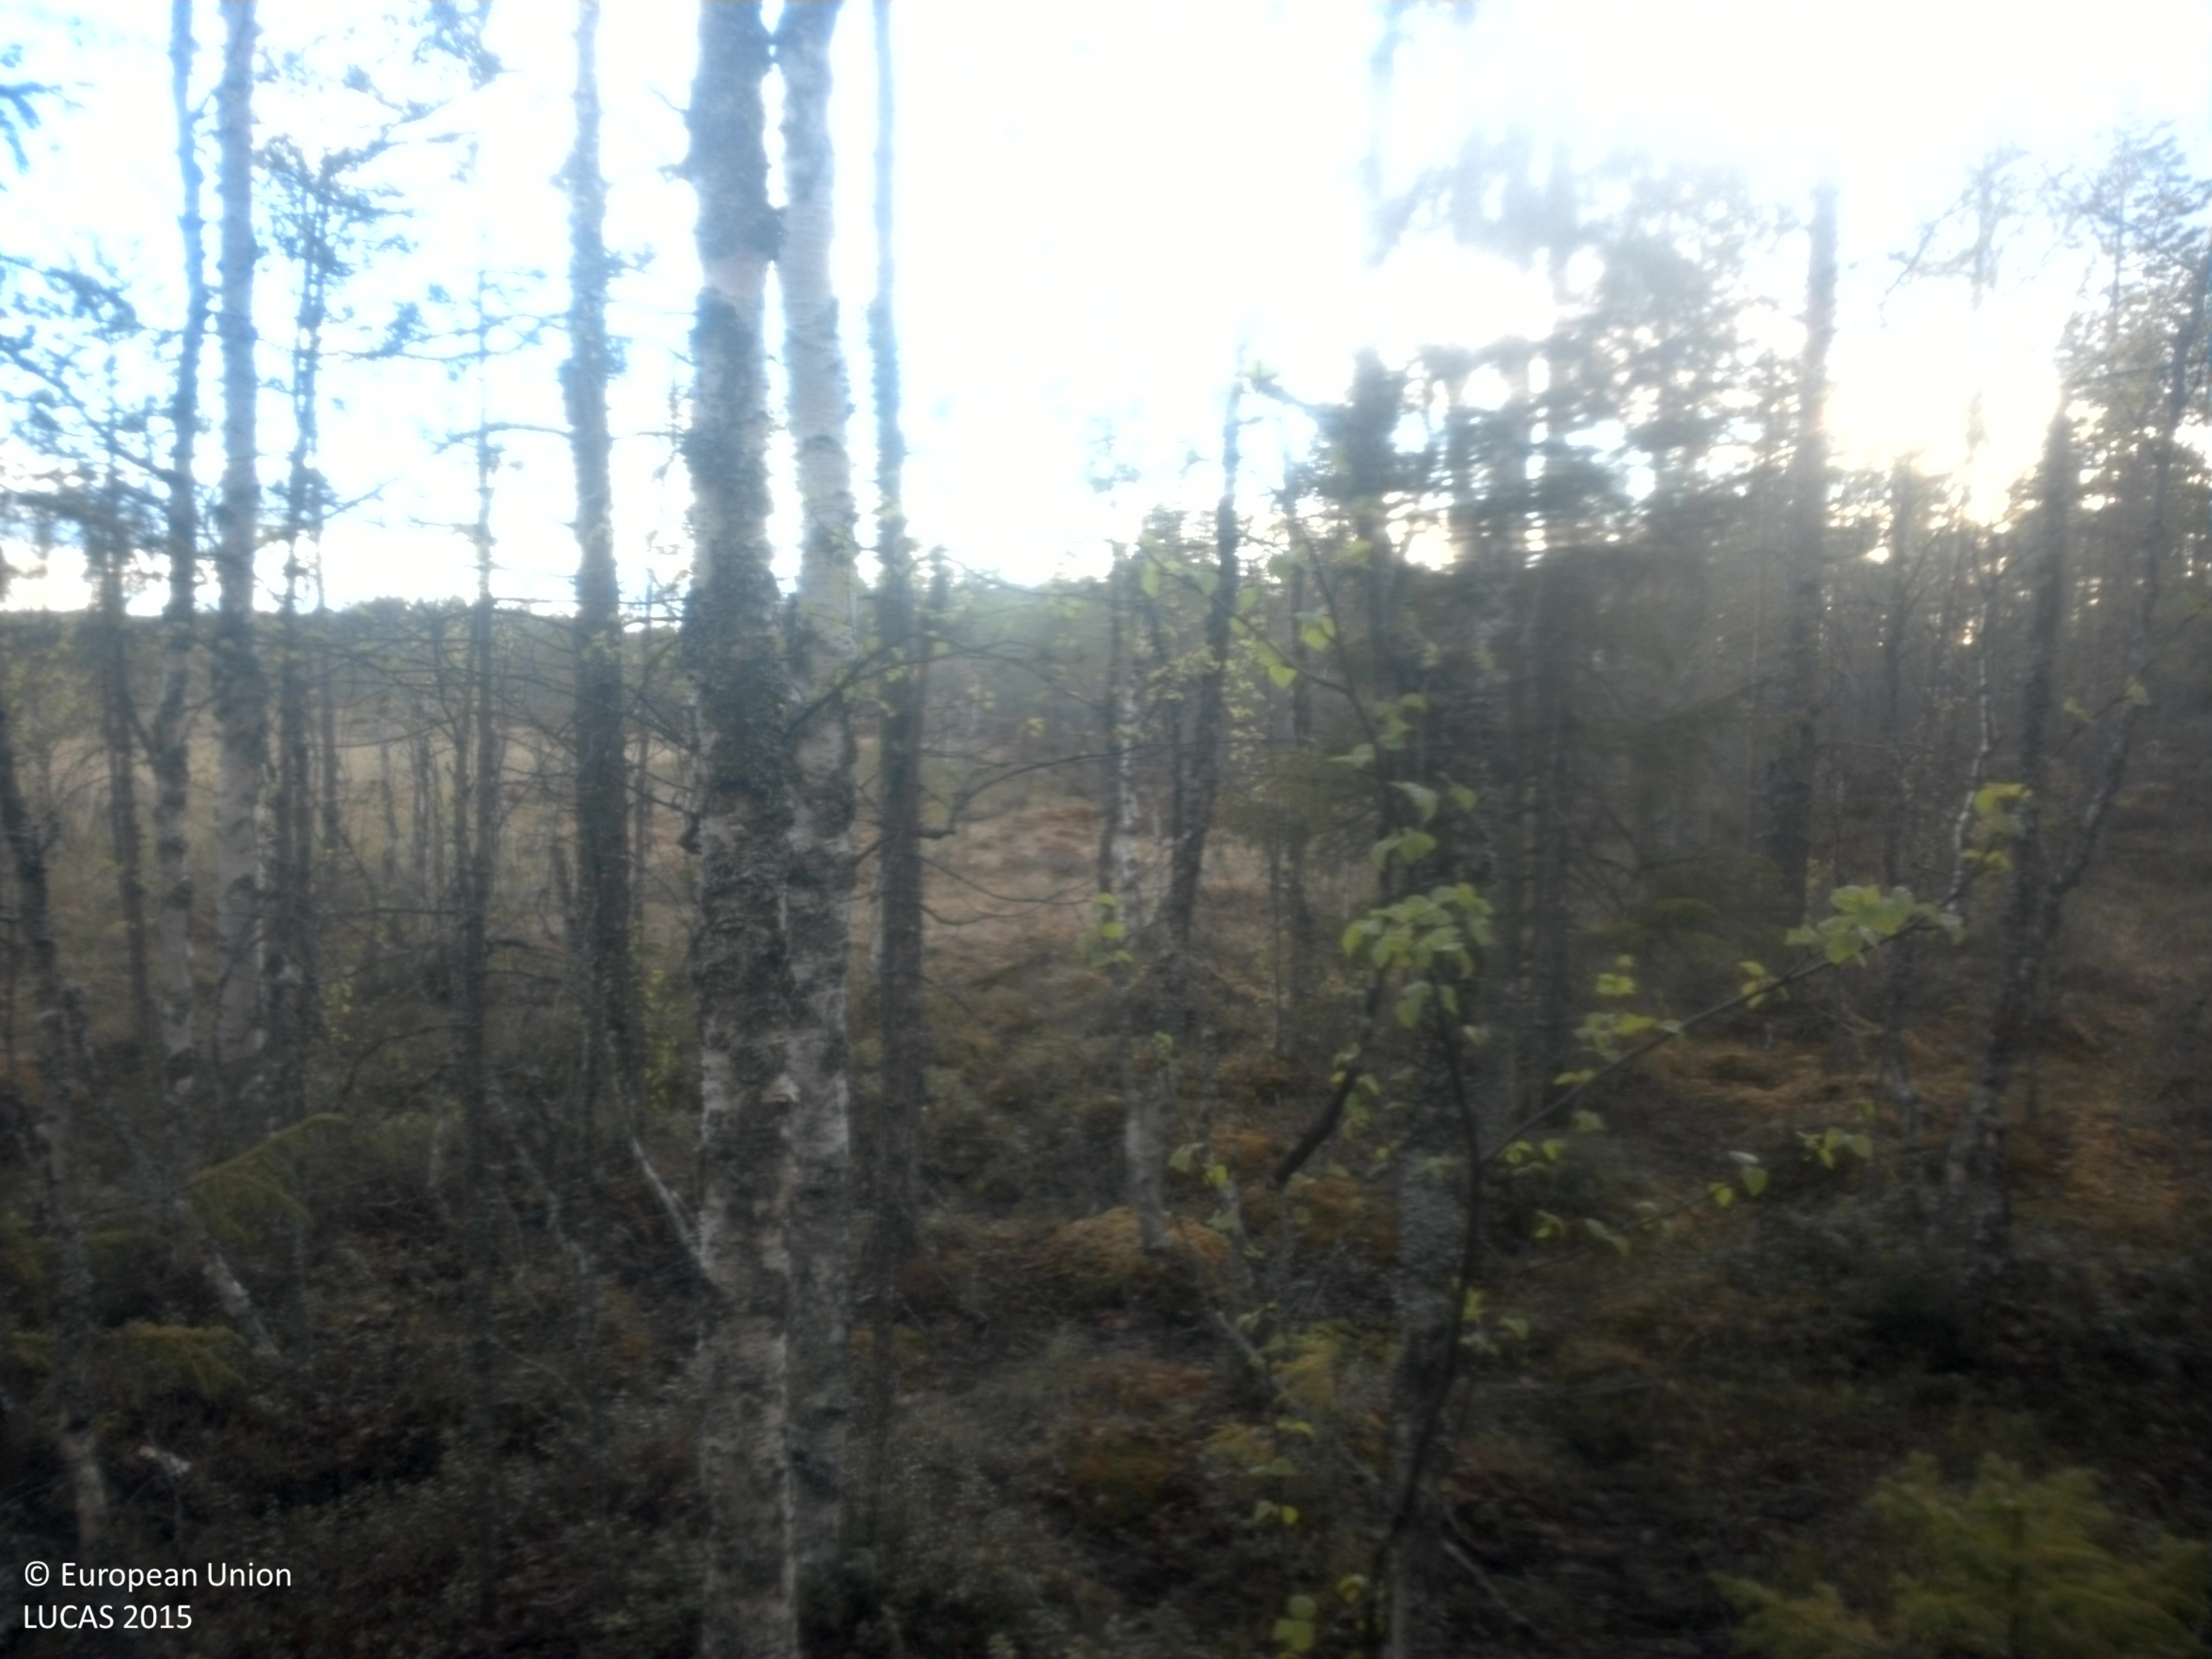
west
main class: Woodland
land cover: Pine dominated coniferous woodland
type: boreal forest
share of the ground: 50 - 75 %
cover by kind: coniferous forest trees 55 %, broadleaved forest trees 10 %, shrubs 10 %, herbaceous plants 10 %, lichens and mosses 10 %, unconsolidated bare surface 5 %
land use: Forestry
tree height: > 5 m
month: June
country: SE
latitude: 64.3945
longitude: 17.6620
